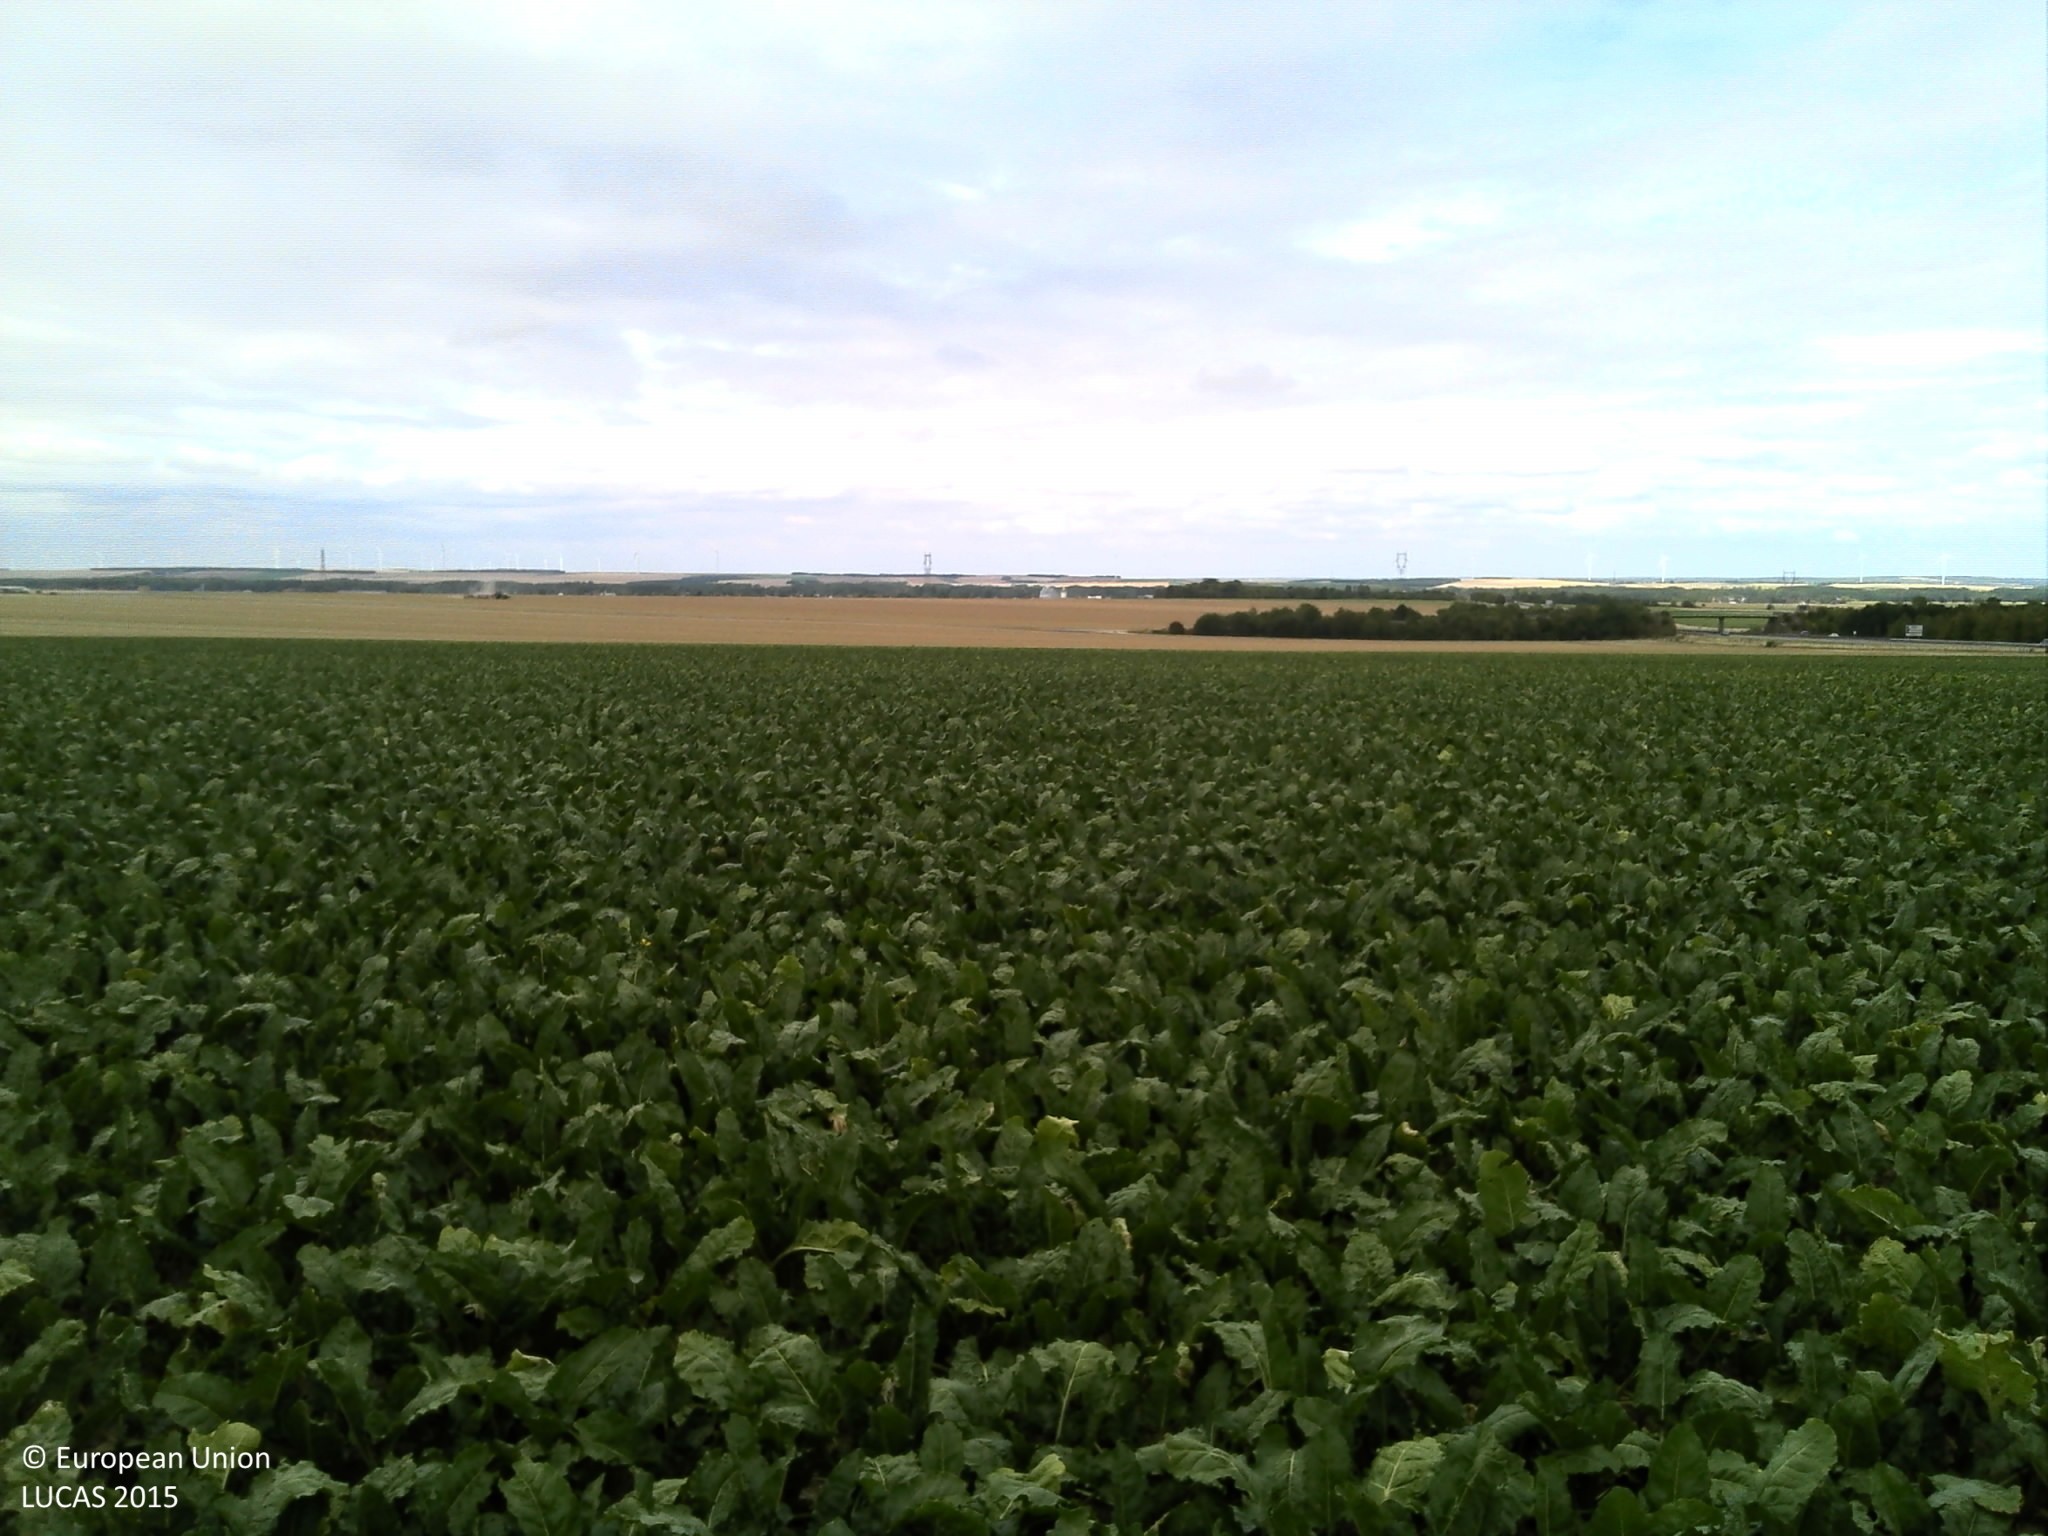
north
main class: Cropland
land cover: Sugar beet
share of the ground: > 75 %
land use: Agriculture (excluding fallow land and kitchen gardens)
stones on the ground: < 10 %
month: August
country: FR
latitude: 48.5019
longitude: 4.1630
